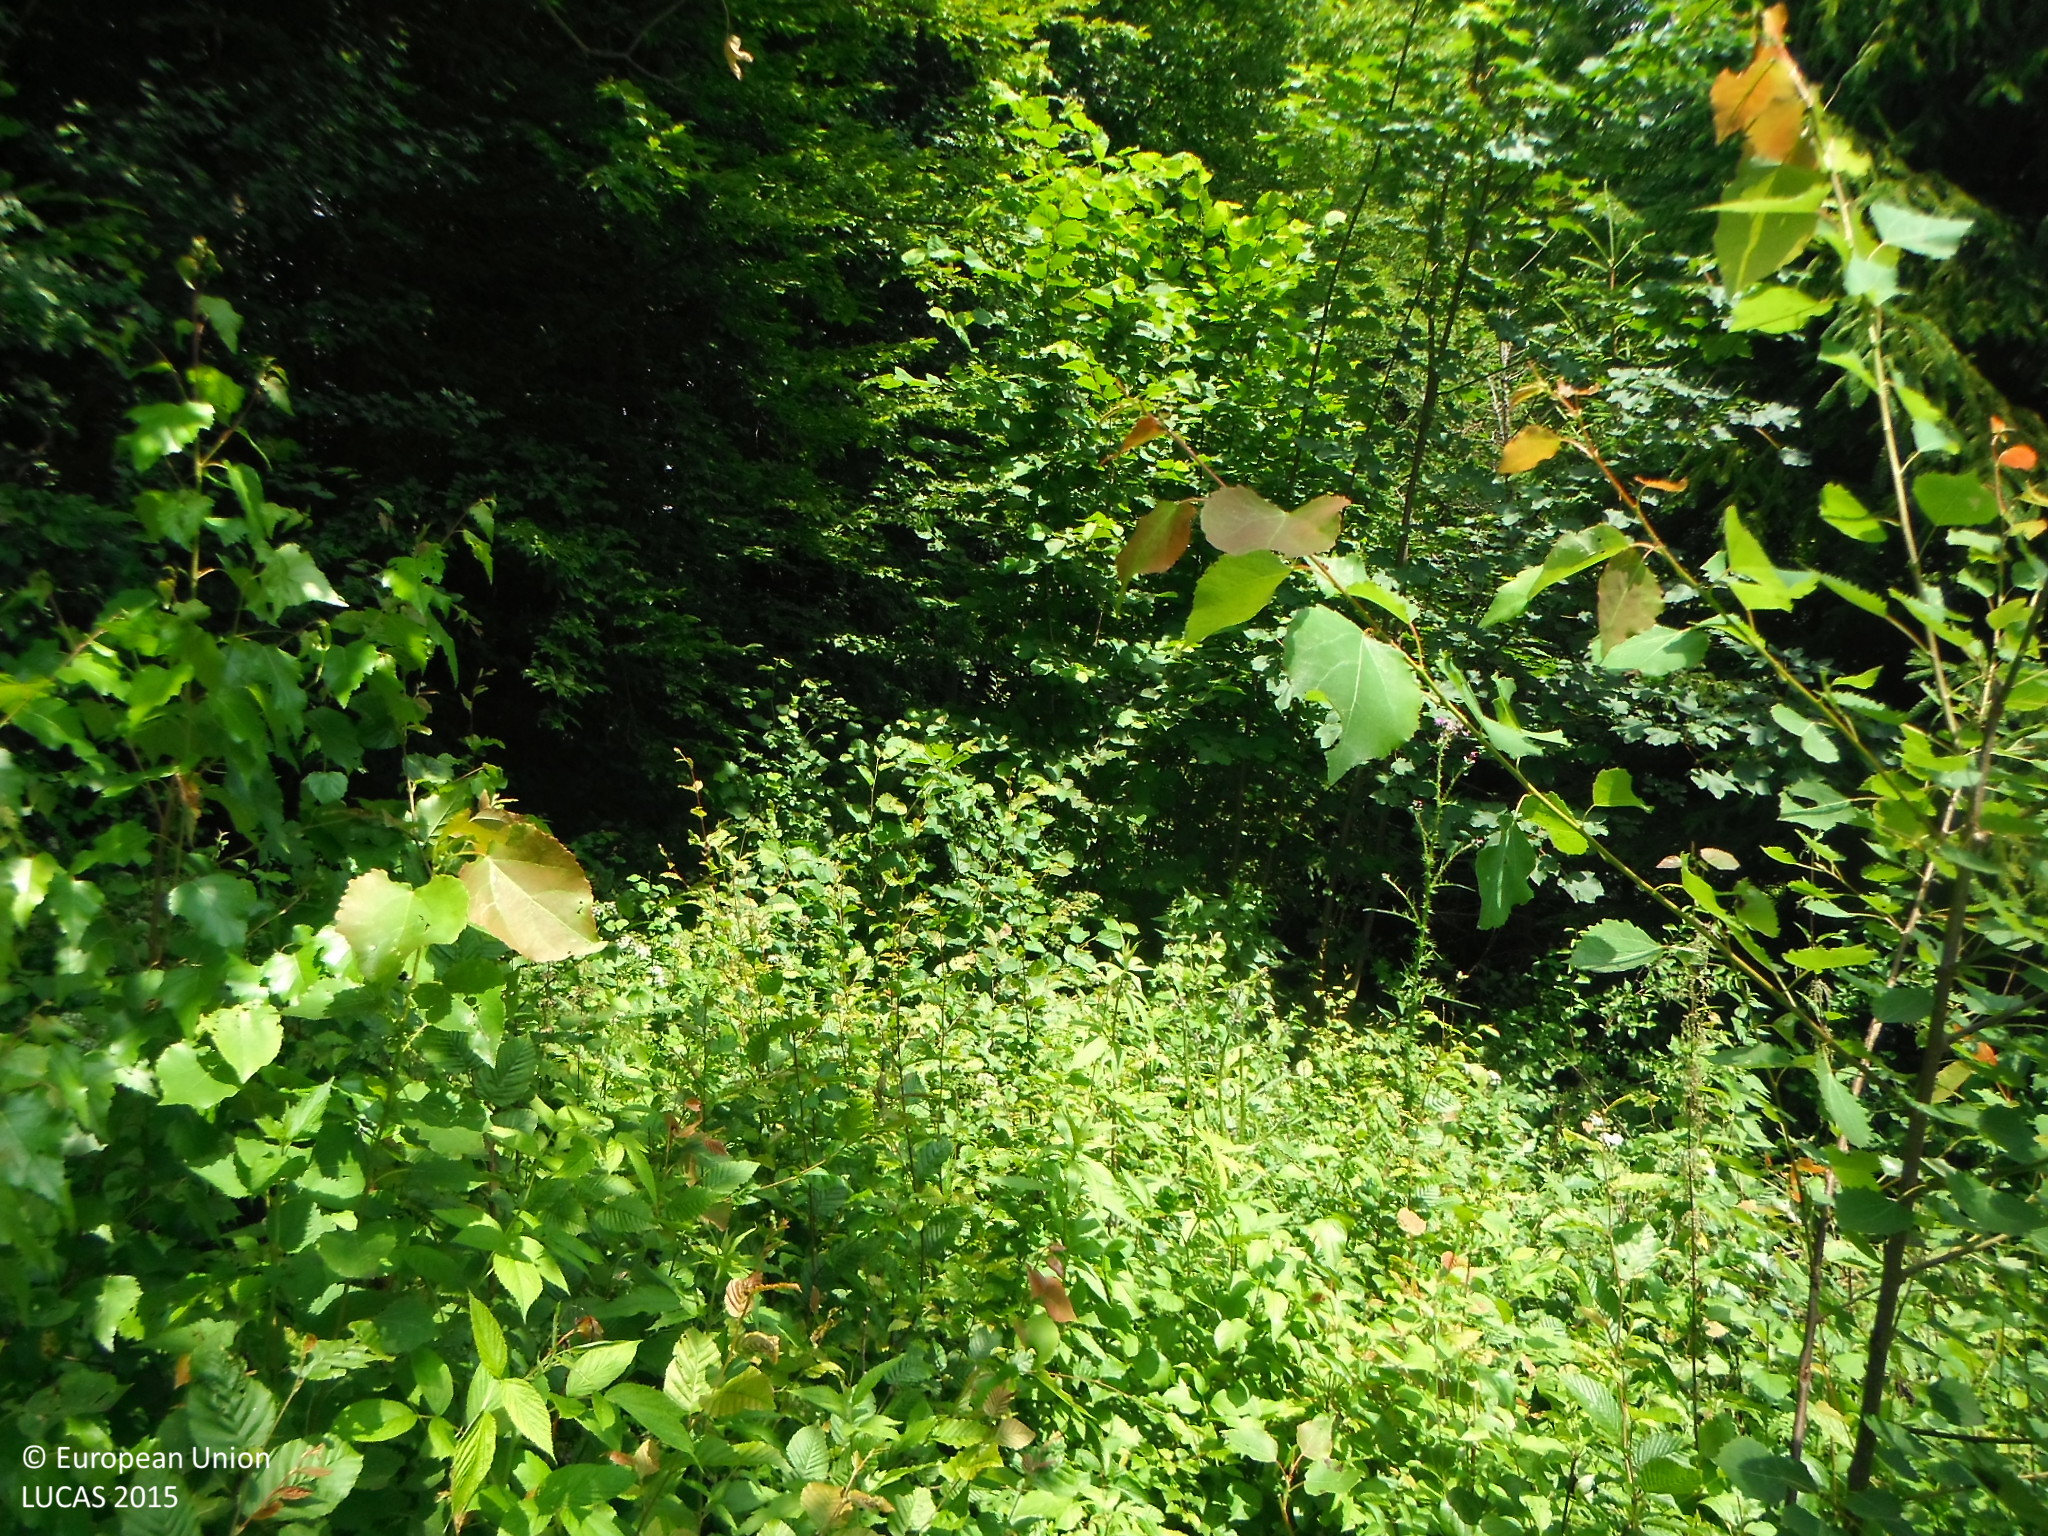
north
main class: Shrubland
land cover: Shrubland with sparse tree cover
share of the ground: > 75 %
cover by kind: shrubs 95 %, broadleaved forest trees 5 %
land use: Semi-natural and natural areas not in use
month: June
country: SK
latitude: 48.8449
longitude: 21.0662
